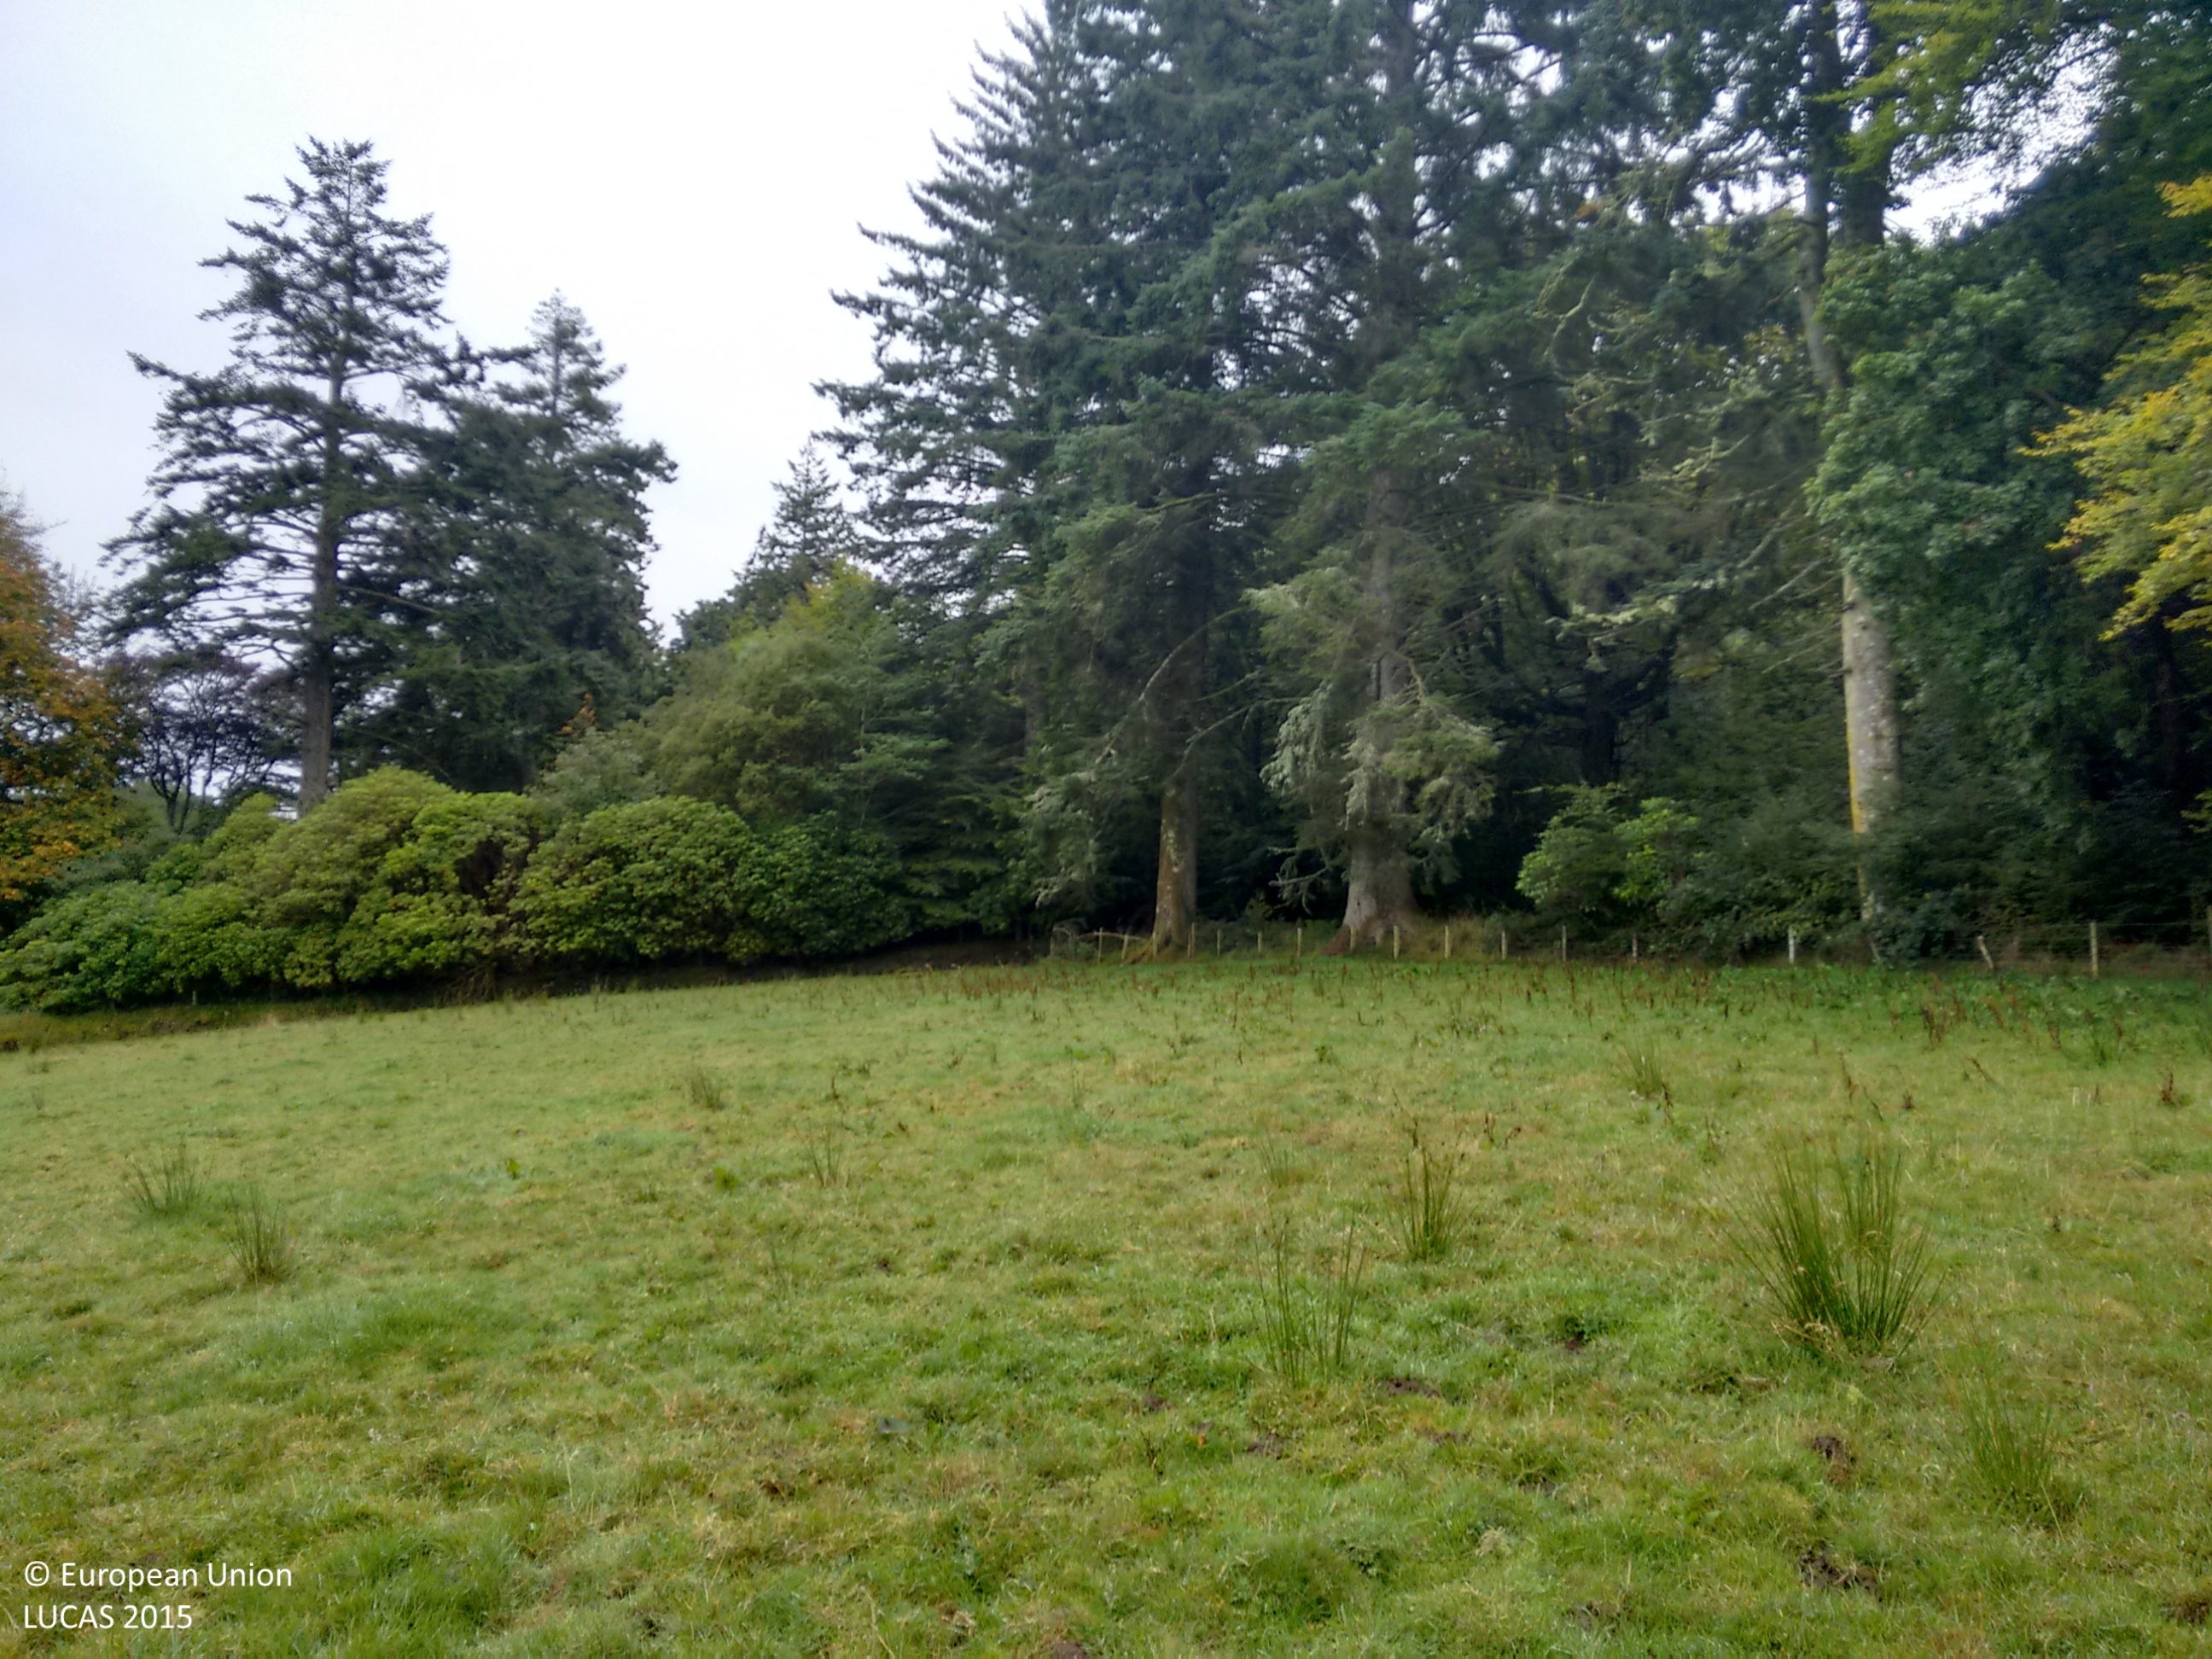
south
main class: Grassland
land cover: Grassland without tree/shrub cover
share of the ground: > 75 %
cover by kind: herbaceous plants 100 %
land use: Agriculture (excluding fallow land and kitchen gardens)
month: September
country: GB
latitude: 55.5300
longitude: -5.5078
